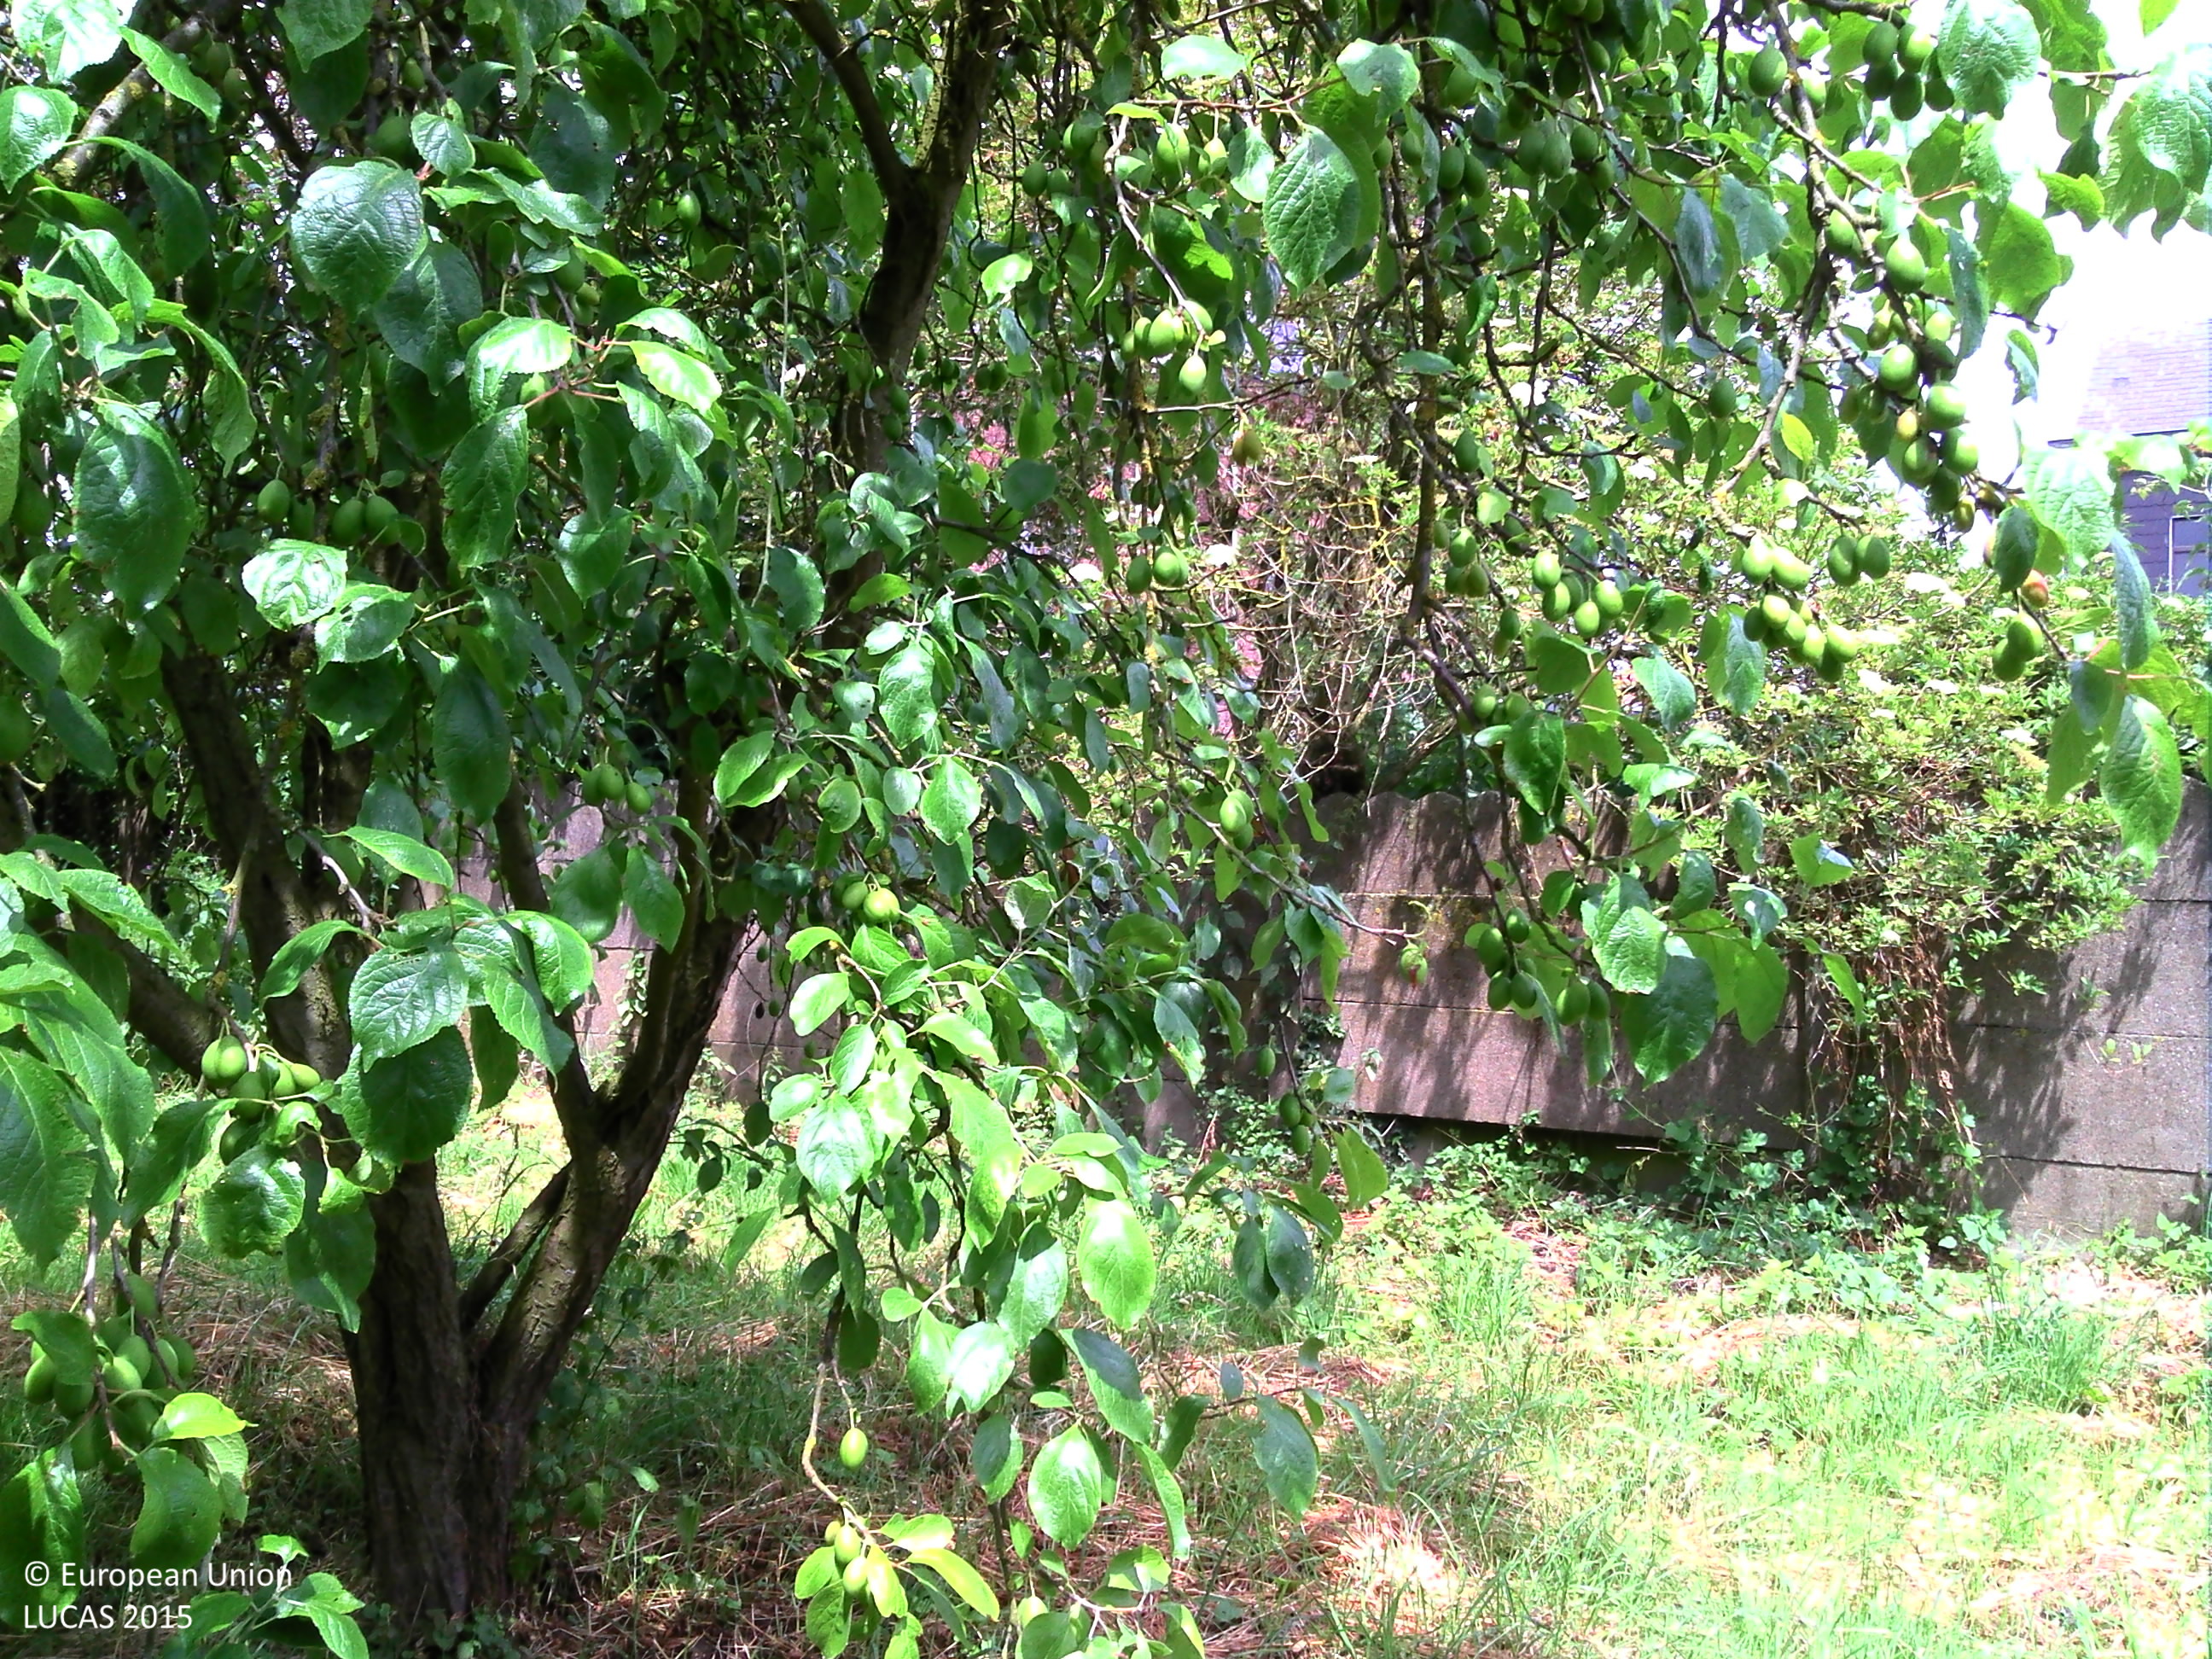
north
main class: Cropland
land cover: Apple fruit
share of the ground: 50 - 75 %
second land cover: Grassland without tree/shrub cover
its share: > 75 %
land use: Agriculture (excluding fallow land and kitchen gardens)
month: June
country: BE
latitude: 50.7261
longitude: 5.5075
